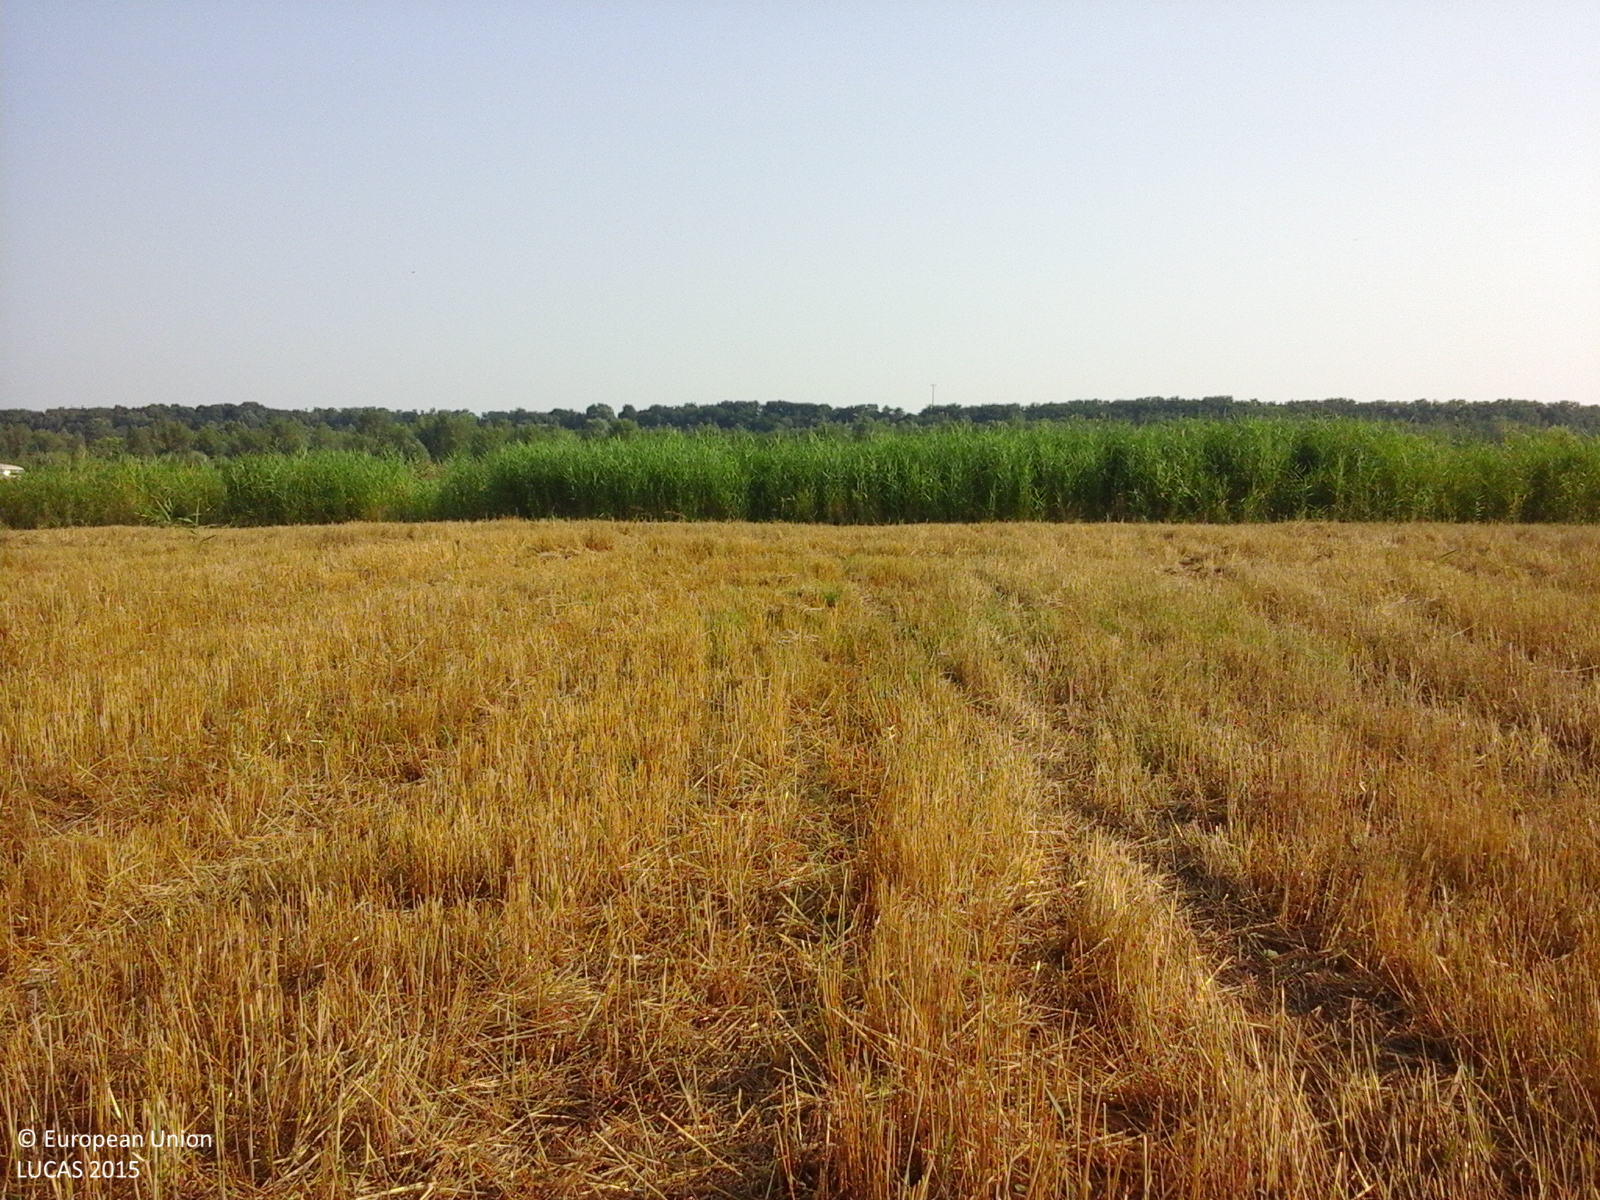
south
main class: Cropland
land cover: Common wheat
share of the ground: < 10 %
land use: Agriculture (excluding fallow land and kitchen gardens)
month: July
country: RO
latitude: 44.8075
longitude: 25.0163
